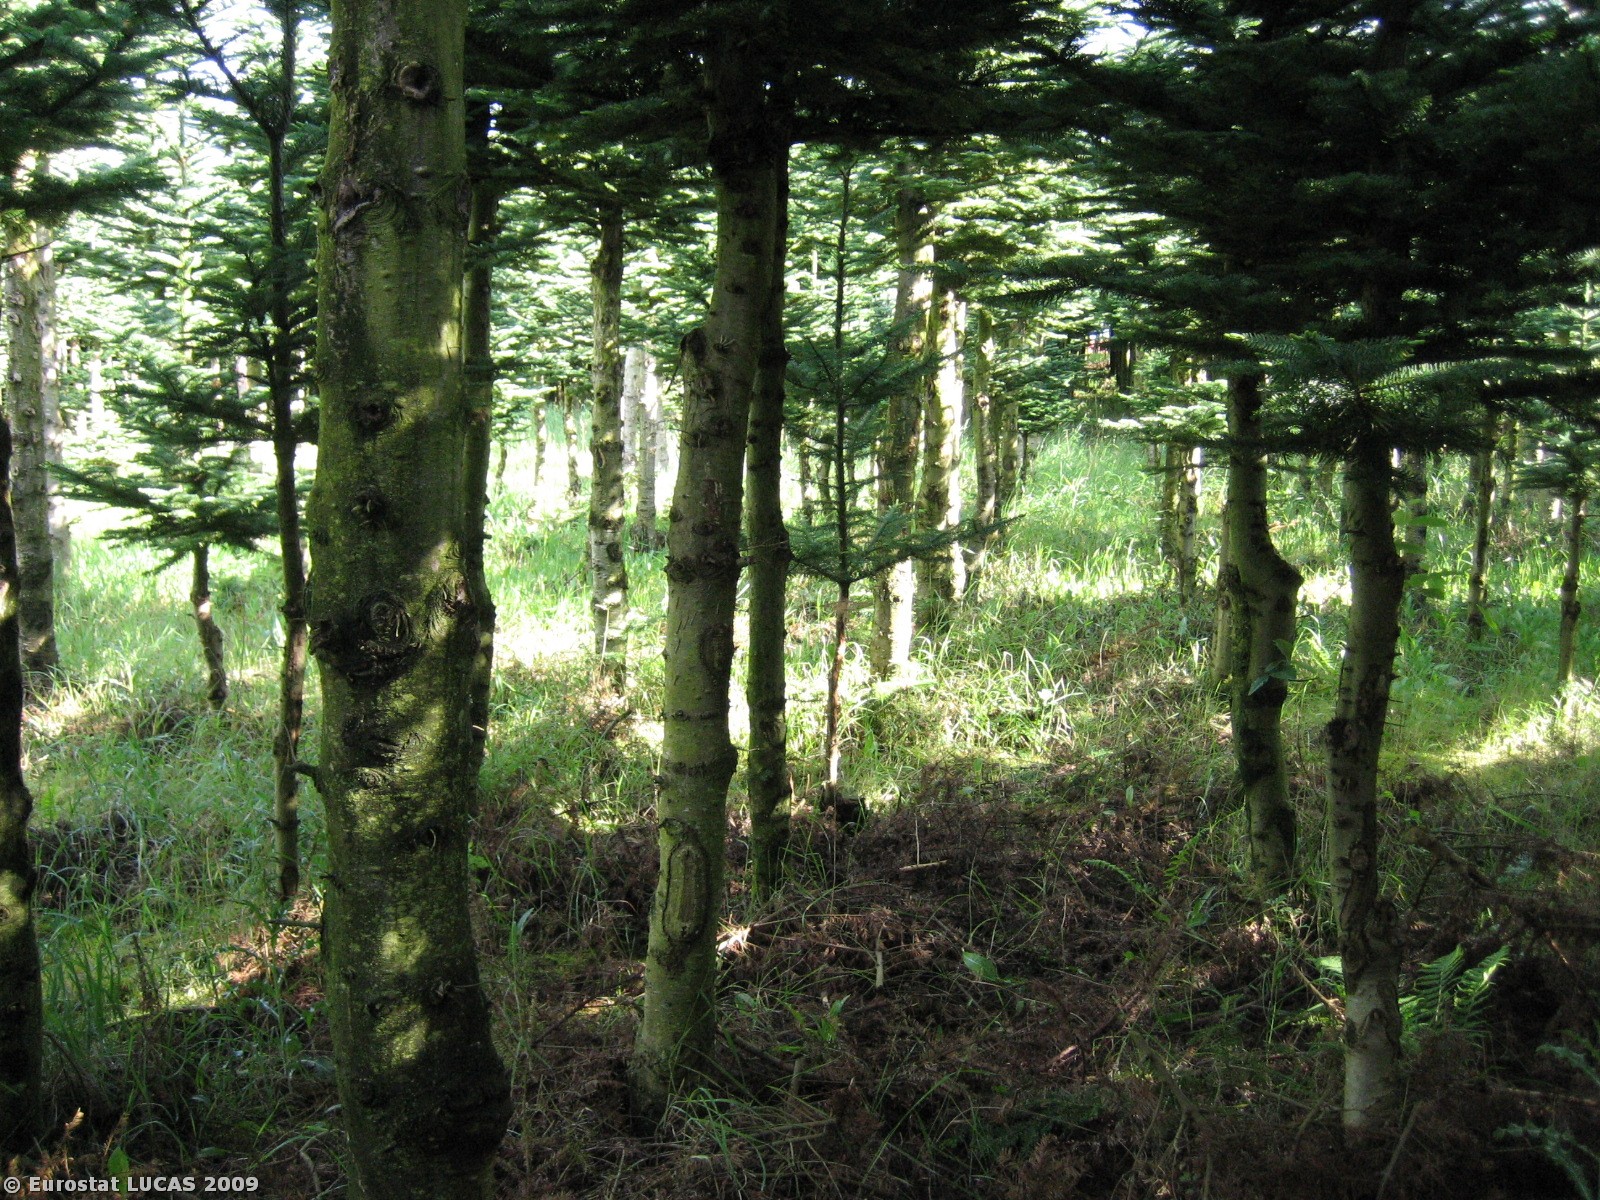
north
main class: Woodland
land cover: Coniferous woodland
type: hemiboreal forest and nemoral coniferous forest and mixed broadleaved-coniferous forest
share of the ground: > 75 %
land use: Forestry
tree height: > 5 m
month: May
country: DK
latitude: 55.8801
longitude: 9.2814
